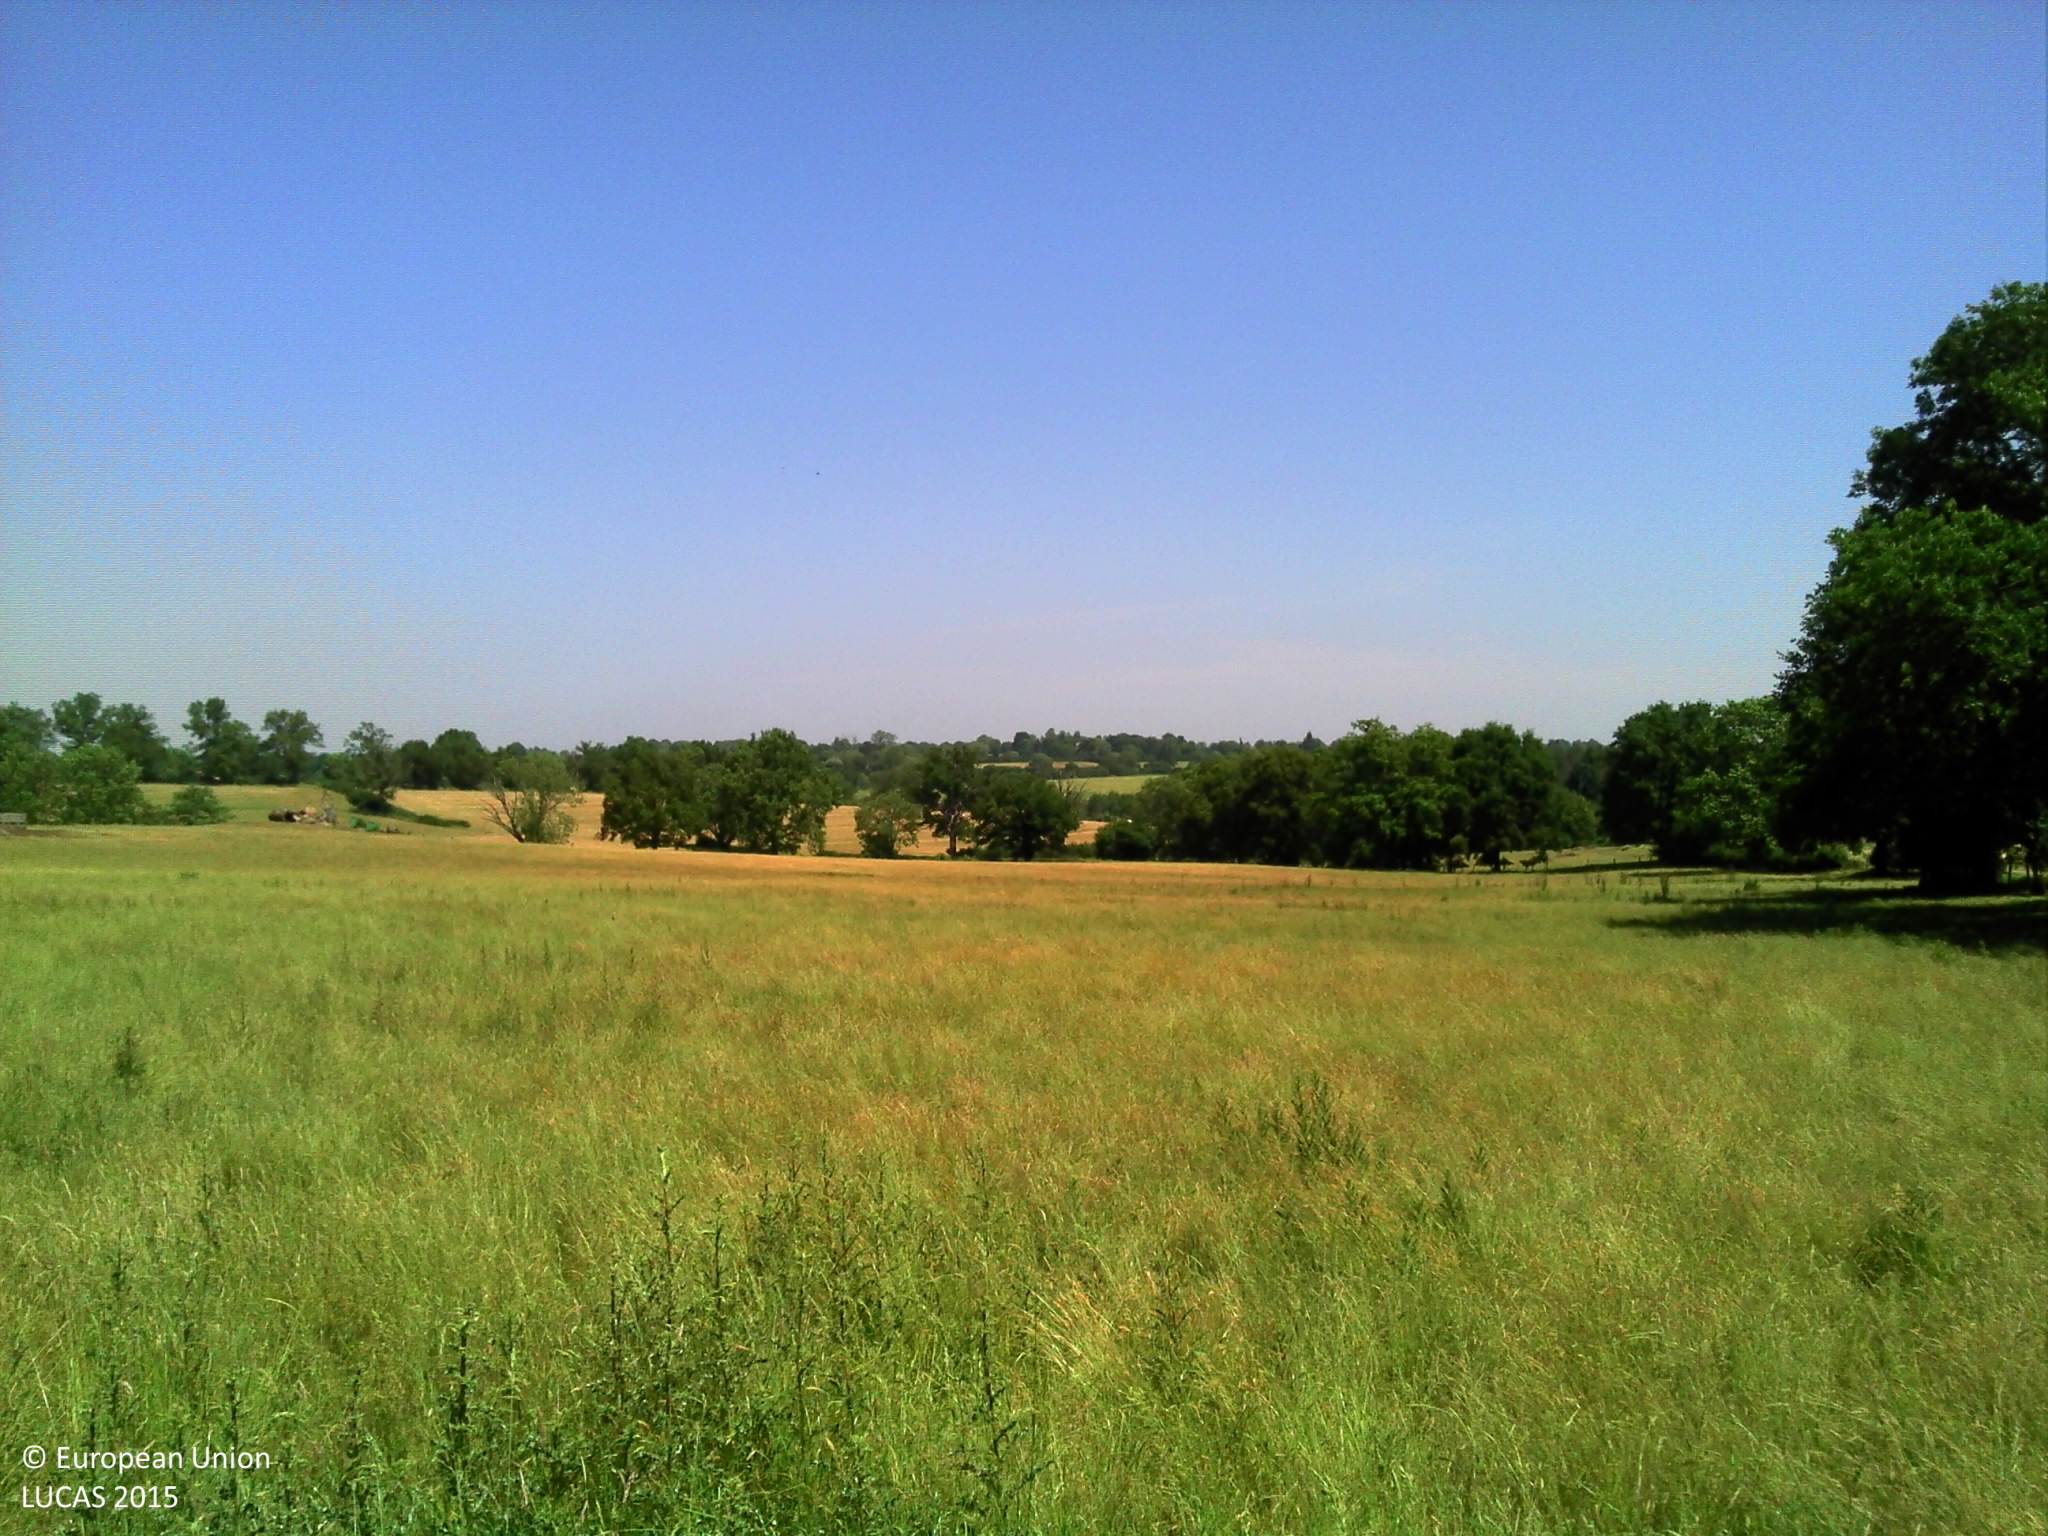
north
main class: Grassland
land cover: Grassland without tree/shrub cover
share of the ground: > 75 %
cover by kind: herbaceous plants 100 %
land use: Agriculture (excluding fallow land and kitchen gardens)
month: June
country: FR
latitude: 46.3742
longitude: 2.9903
